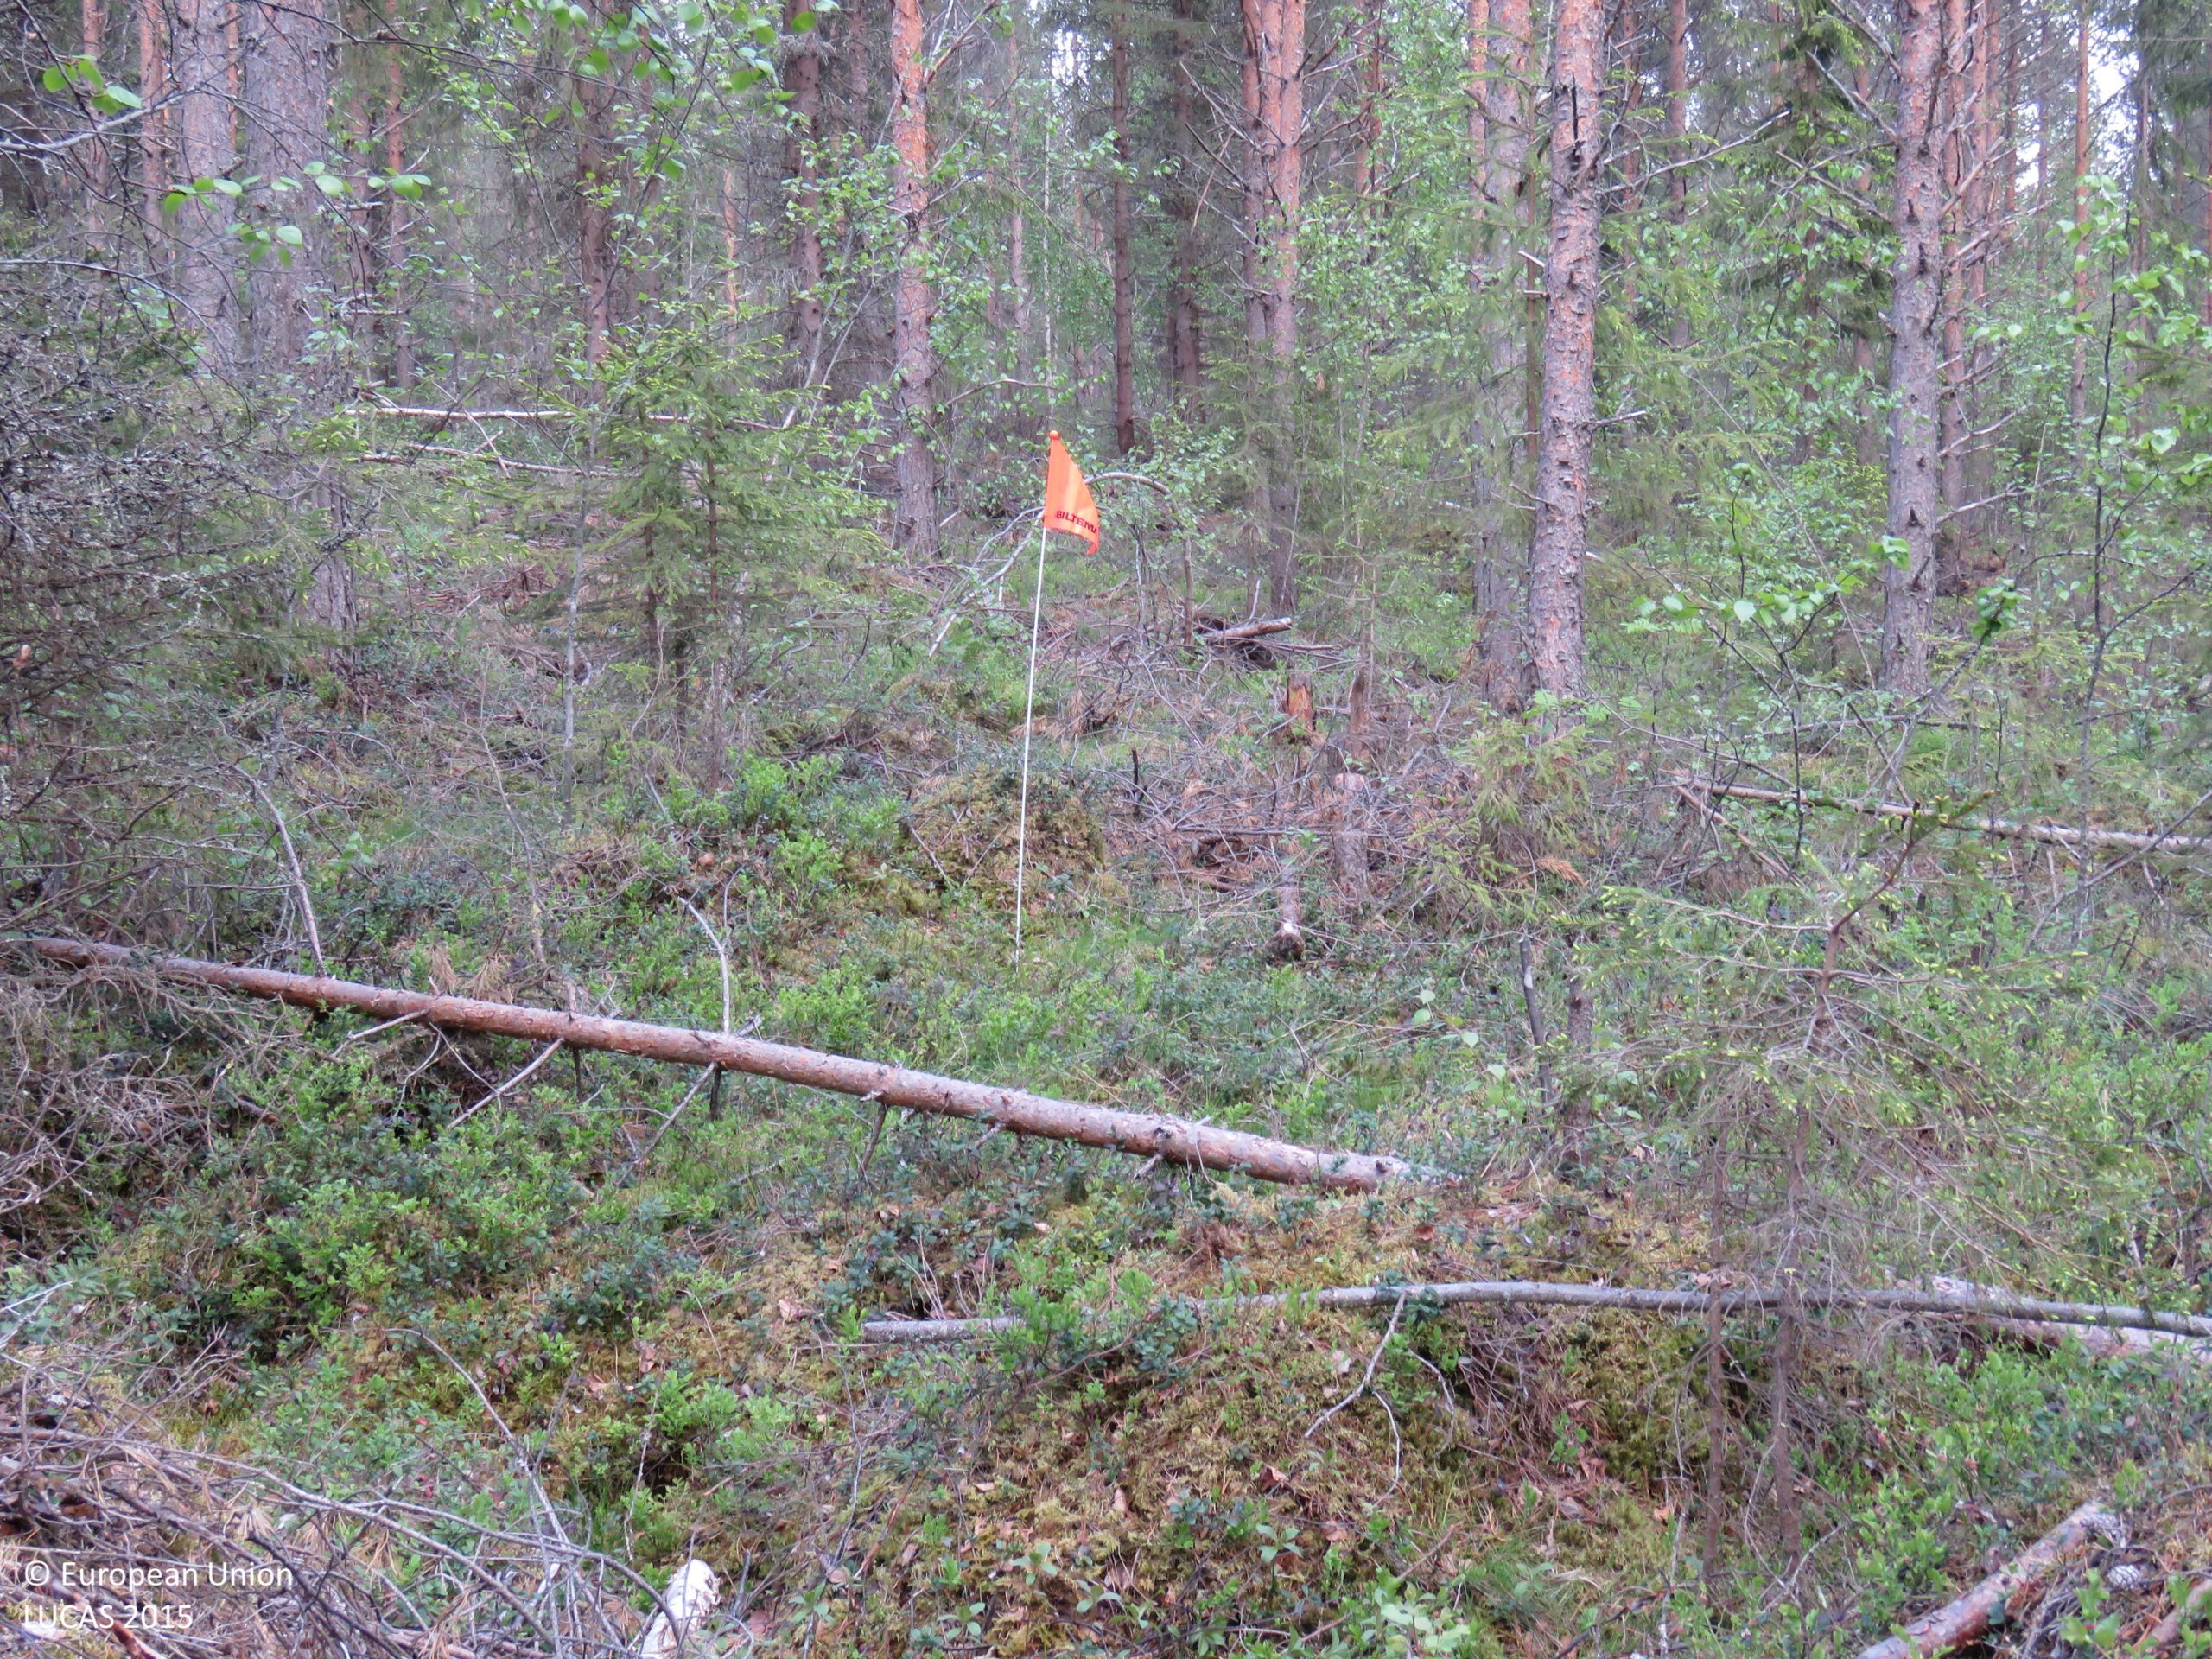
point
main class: Woodland
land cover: Other coniferous woodland
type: boreal forest
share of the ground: 50 - 75 %
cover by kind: coniferous forest trees 60 %, shrubs 30 %, broadleaved forest trees 5 %, lichens and mosses 5 %
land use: Forestry
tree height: > 5 m
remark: Clear cut
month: June
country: FI
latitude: 65.0524
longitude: 25.7053
